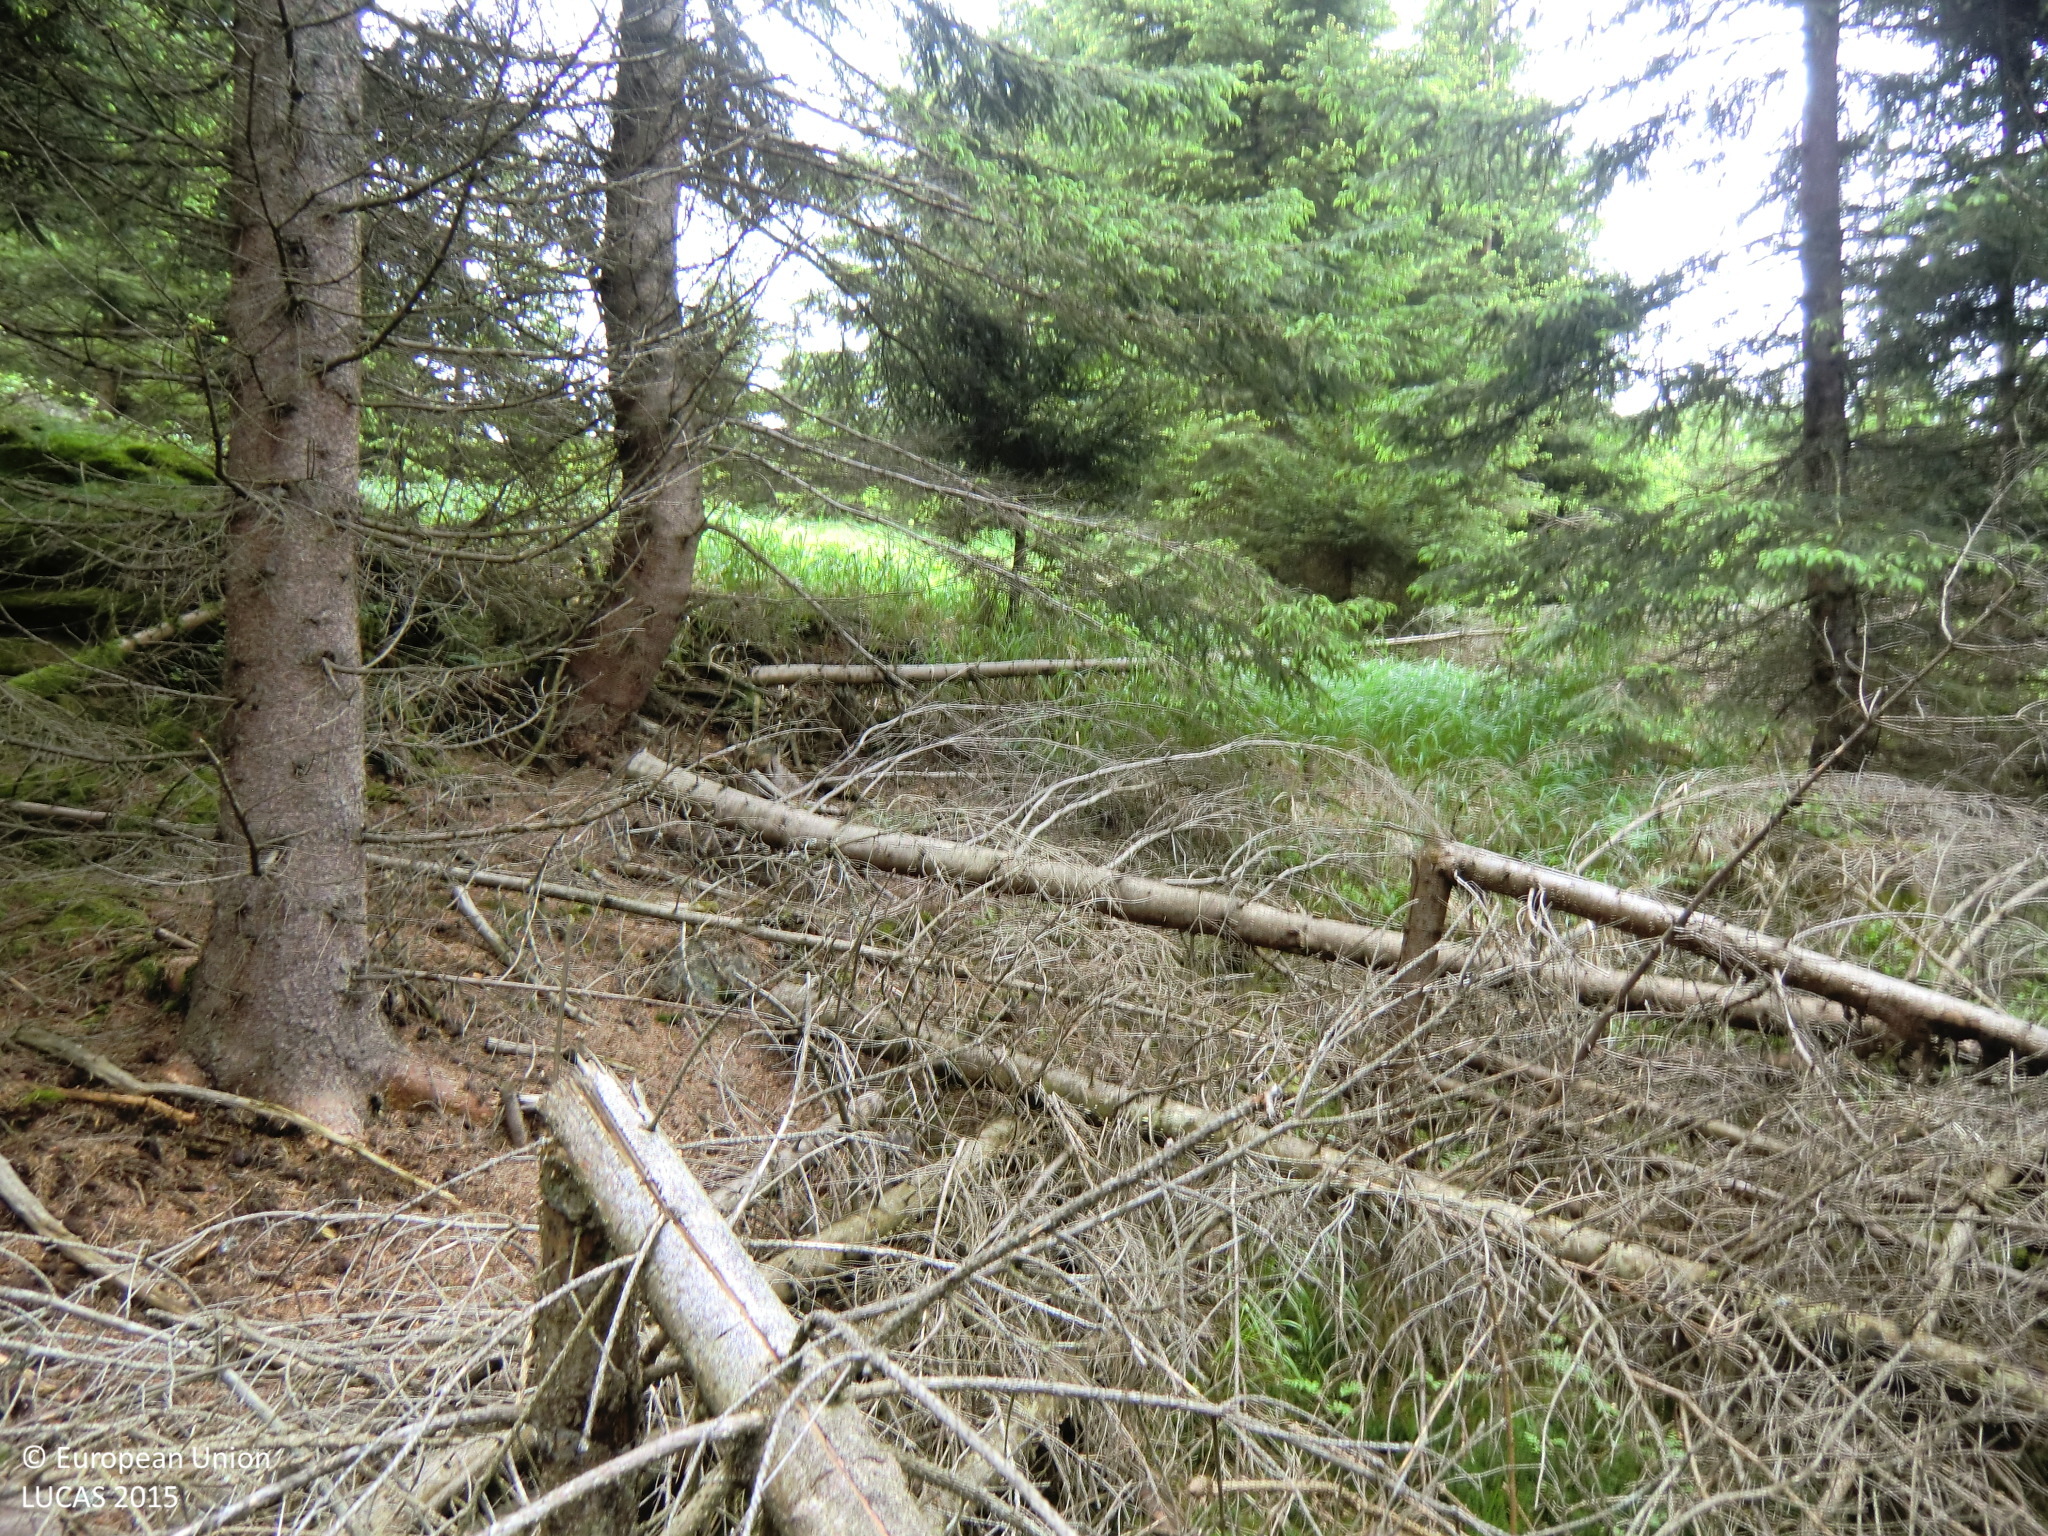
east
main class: Woodland
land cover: Spruce dominated coniferous woodland
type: hemiboreal forest and nemoral coniferous forest and mixed broadleaved-coniferous forest
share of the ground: 50 - 75 %
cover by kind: coniferous forest trees 50 %, herbaceous plants 20 %, shrubs 15 %, unconsolidated bare surface 15 %
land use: Forestry
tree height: > 5 m
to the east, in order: Spruce dominated coniferous woodland; Tracks; Spruce dominated coniferous woodland; Shrubland with sparse tree cover; Tracks; Spruce dominated coniferous woodland; Rivers and streams; Shrubland with sparse tree cover; Tracks; Spruce dominated coniferous woodland; Rivers and streams
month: May
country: AT
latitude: 48.3801
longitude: 15.0107
